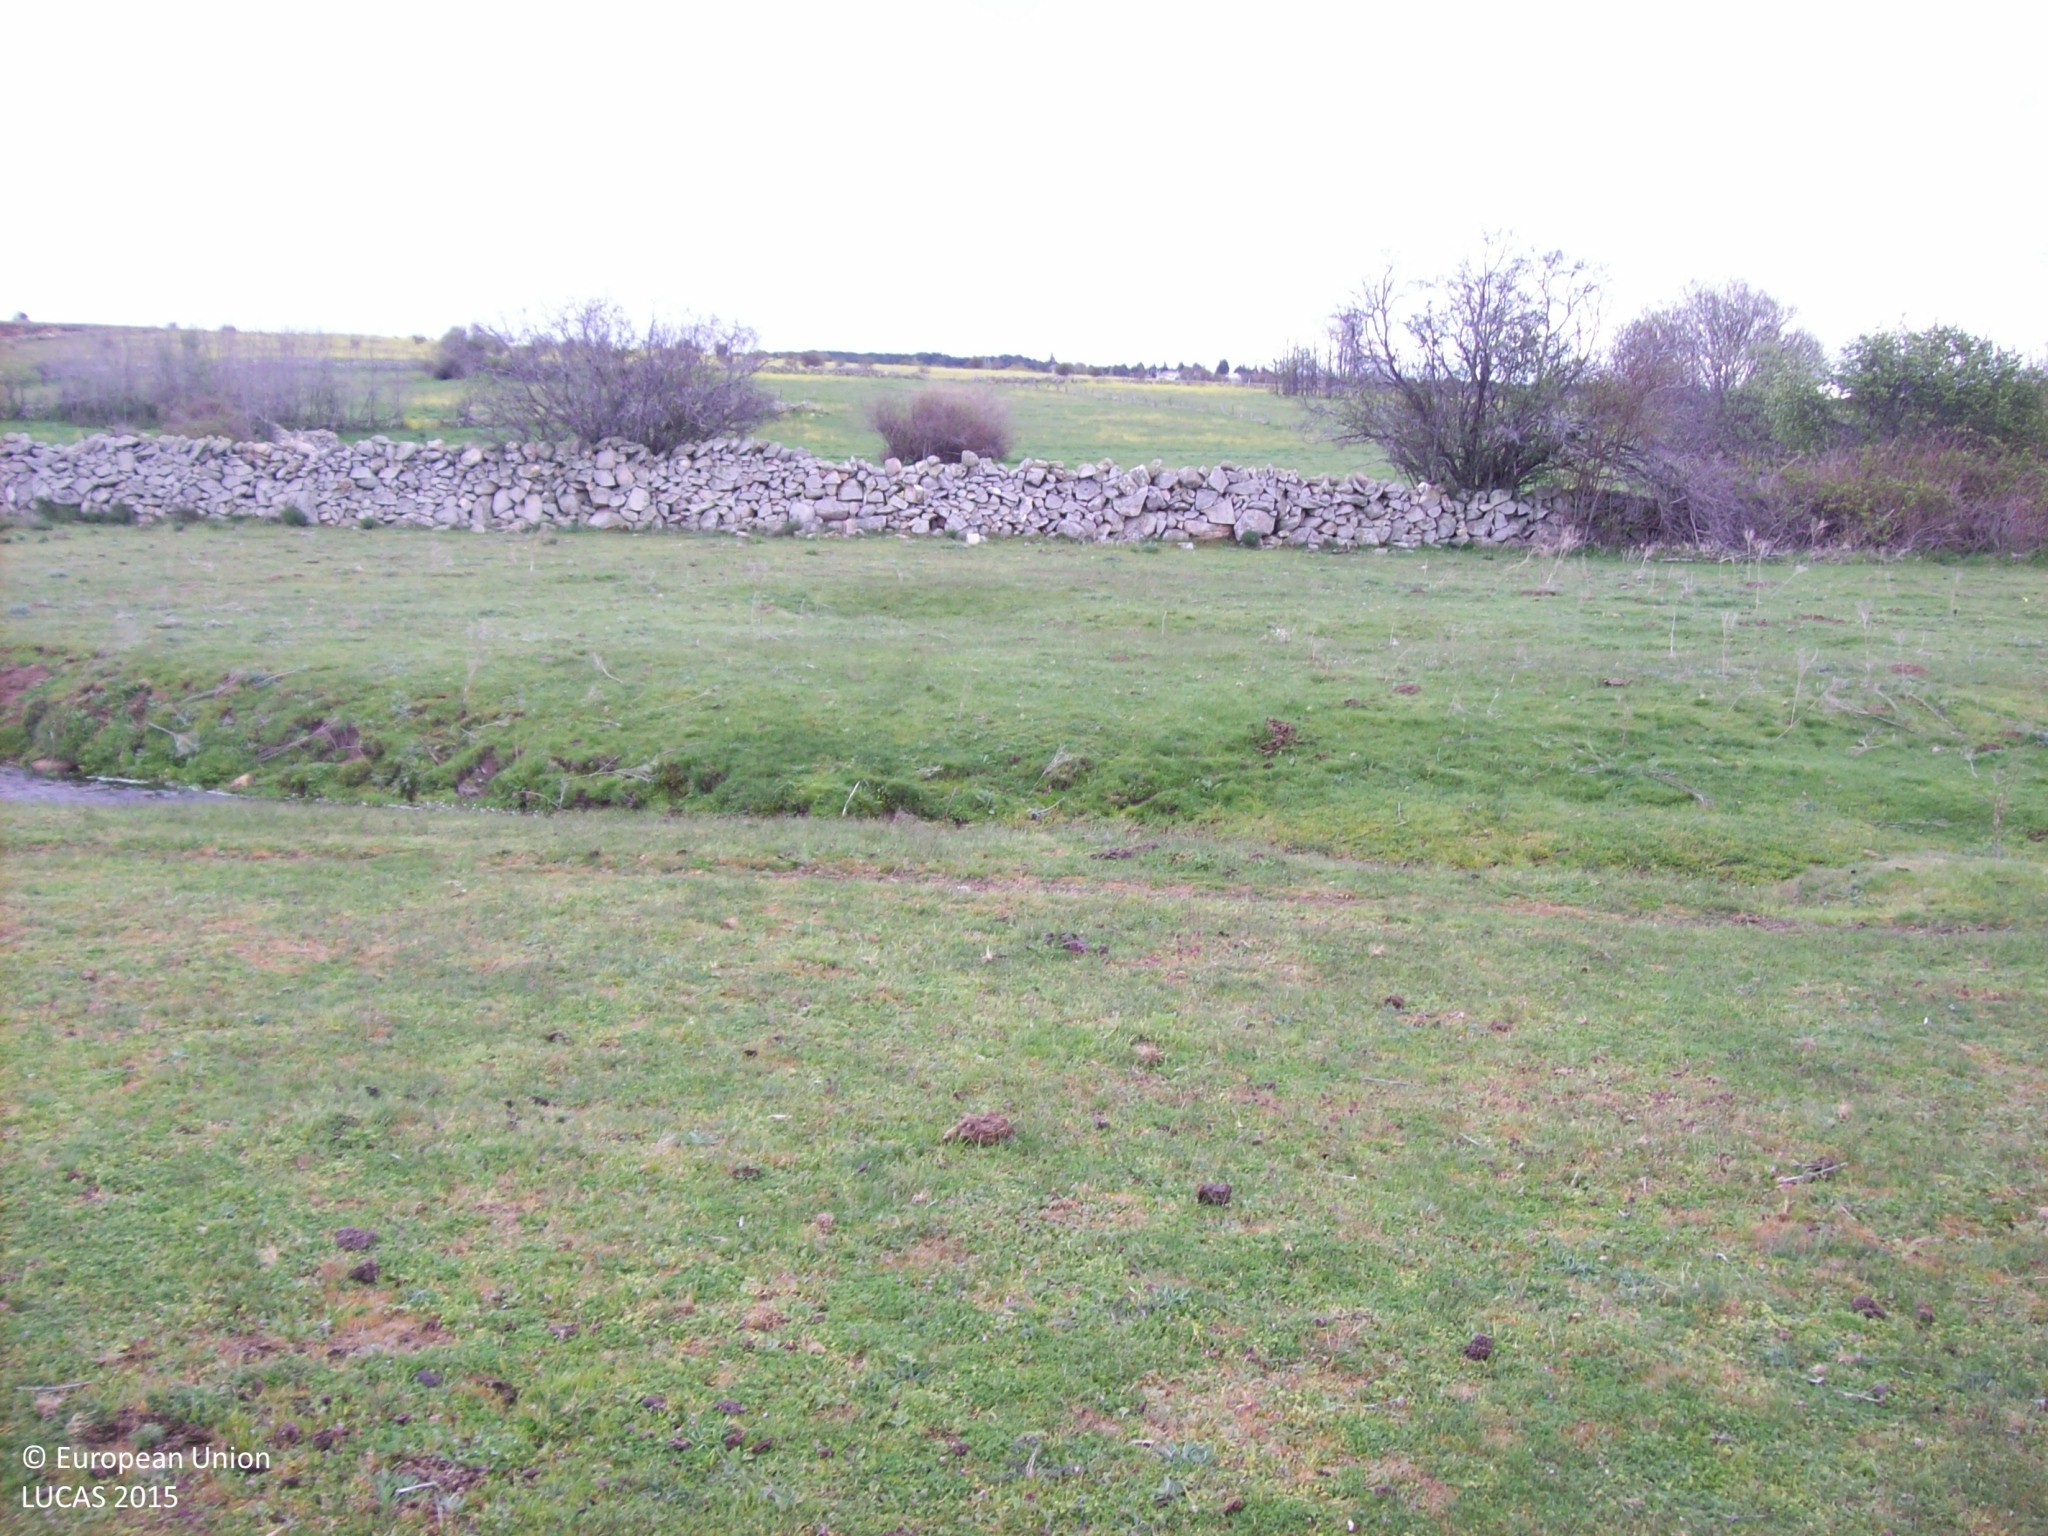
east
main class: Grassland
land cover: Grassland without tree/shrub cover
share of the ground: > 75 %
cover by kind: herbaceous plants 95 %
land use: Agriculture (excluding fallow land and kitchen gardens)
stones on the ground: < 10 %
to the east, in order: Grassland without tree/shrub cover; Rivers and streams; Grassland without tree/shrub cover; Dry stone walls; Grassland without tree/shrub cover; Single bushes/trees; Grassland without tree/shrub cover; Single bushes/trees; Grassland without tree/shrub cover
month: April
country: ES
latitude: 40.5884
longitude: -4.4295
